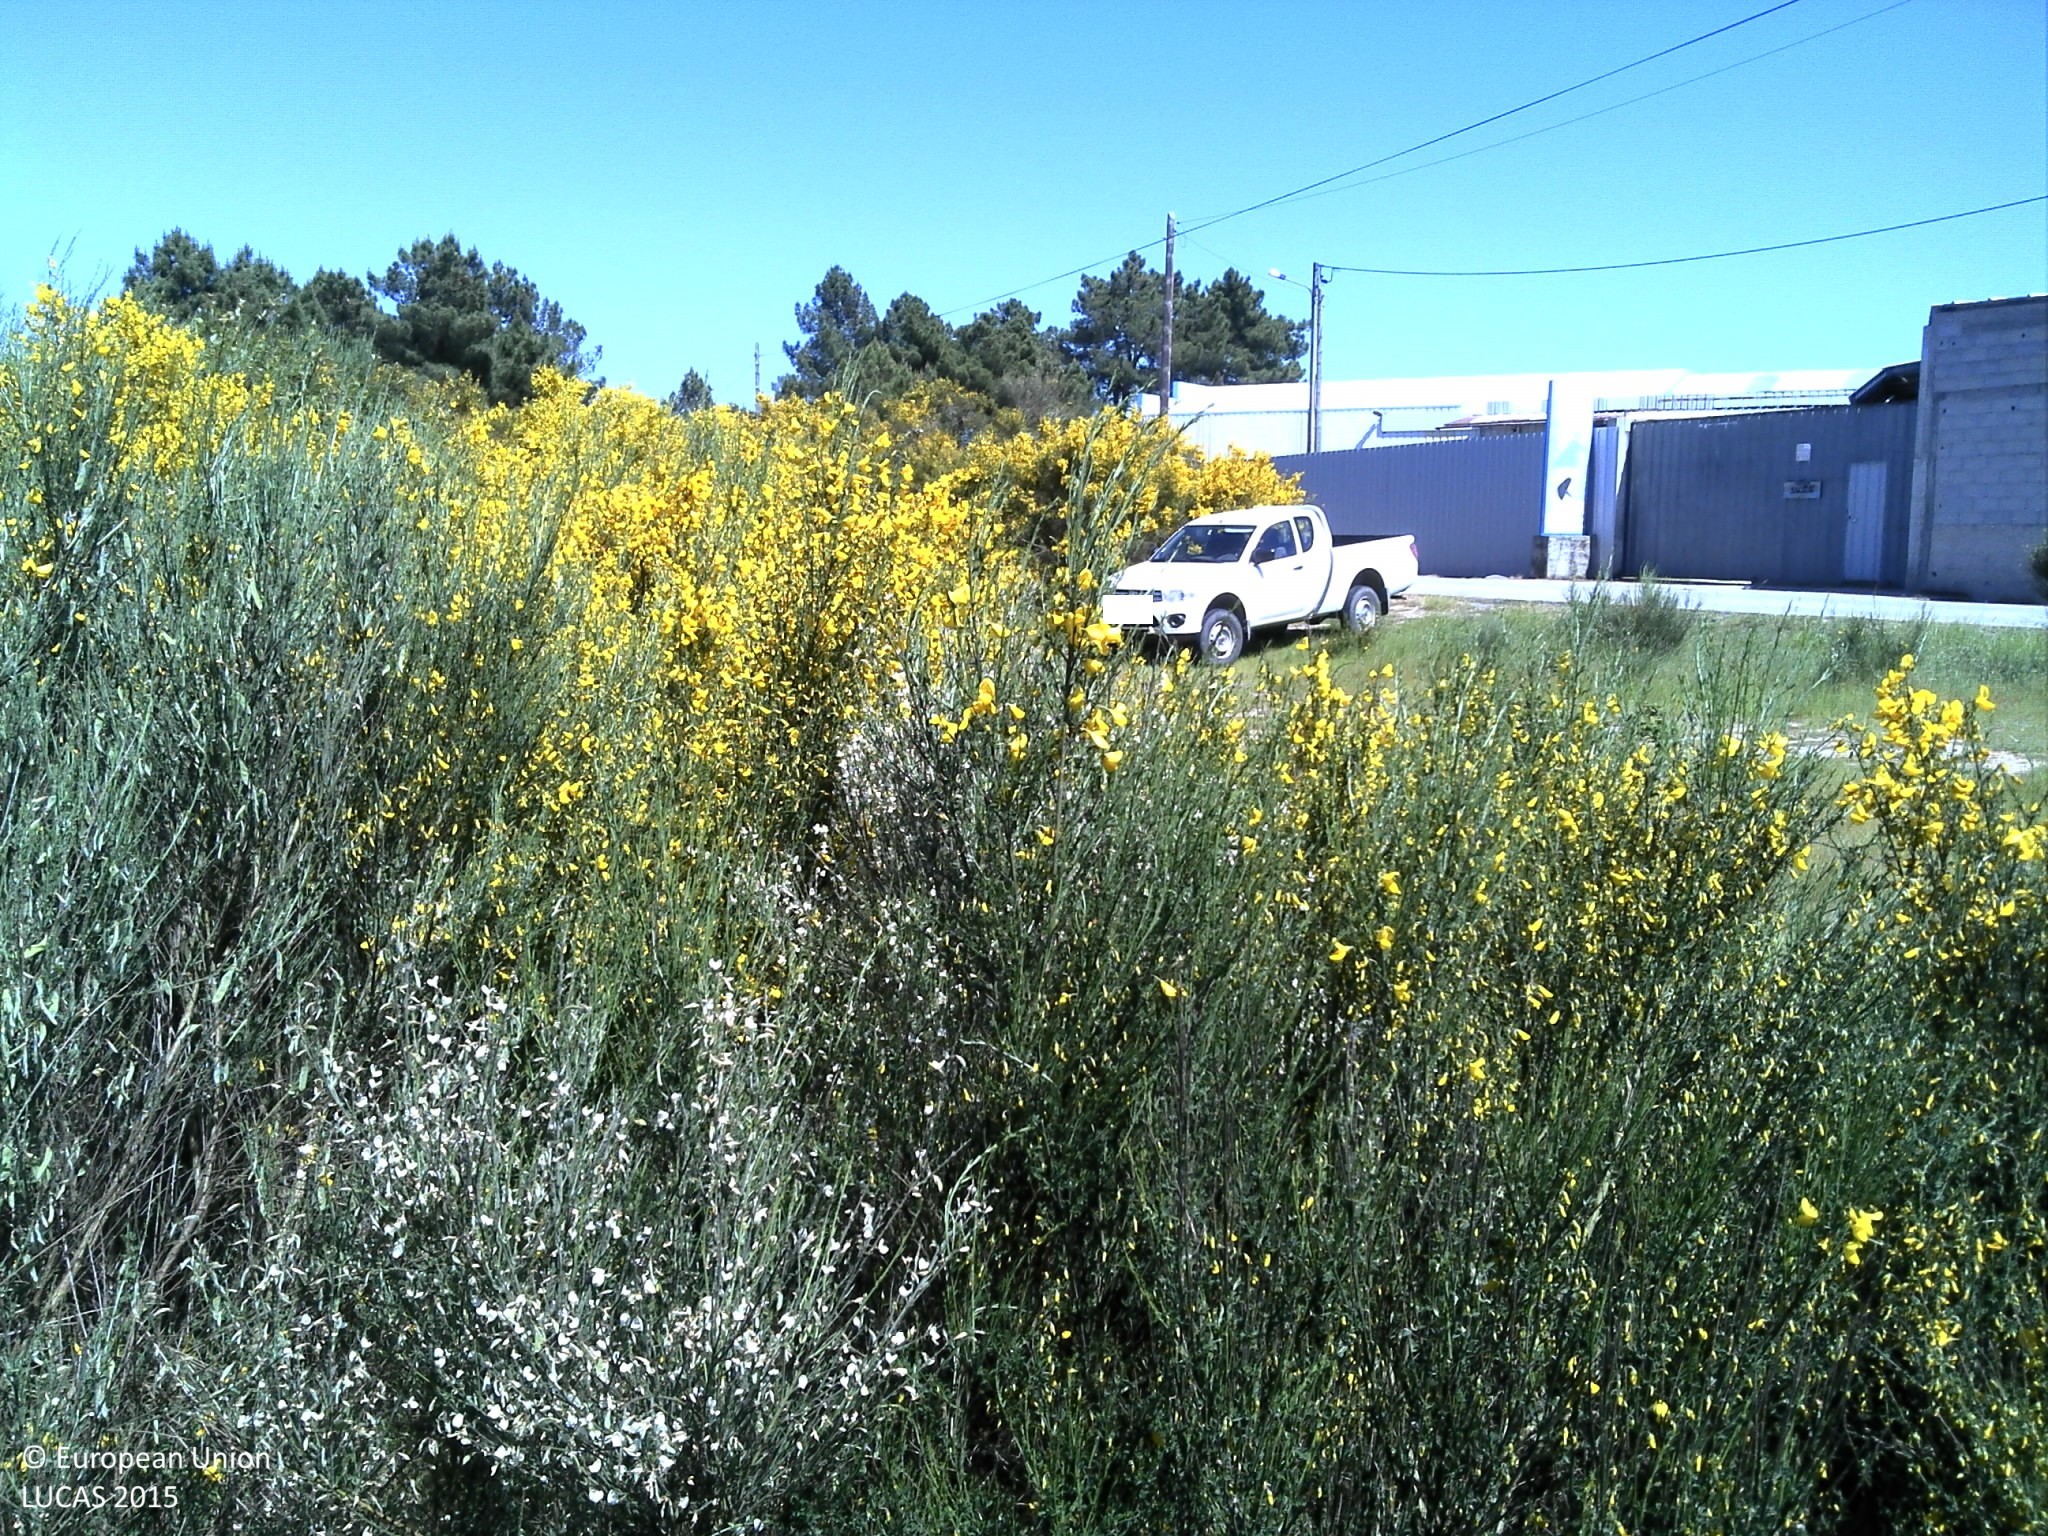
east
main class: Shrubland
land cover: Shrubland without tree cover
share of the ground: 50 - 75 %
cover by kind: shrubs 65 %, herbaceous plants 20 %, unconsolidated bare surface 15 %
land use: Forestry
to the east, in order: Shrubland without tree cover; Spontaneously vegetated surfaces; Shrubland without tree cover; Dry stone walls; Electric lines; Paved roads, cycling and walking lanes; Ditches and canals; Pine dominated coniferous woodland; Tracks; Shrubland without tree cover; Tracks; Shrubland without tree cover; Spontaneously vegetated surfaces
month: May
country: PT
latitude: 41.8021
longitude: -7.3756
